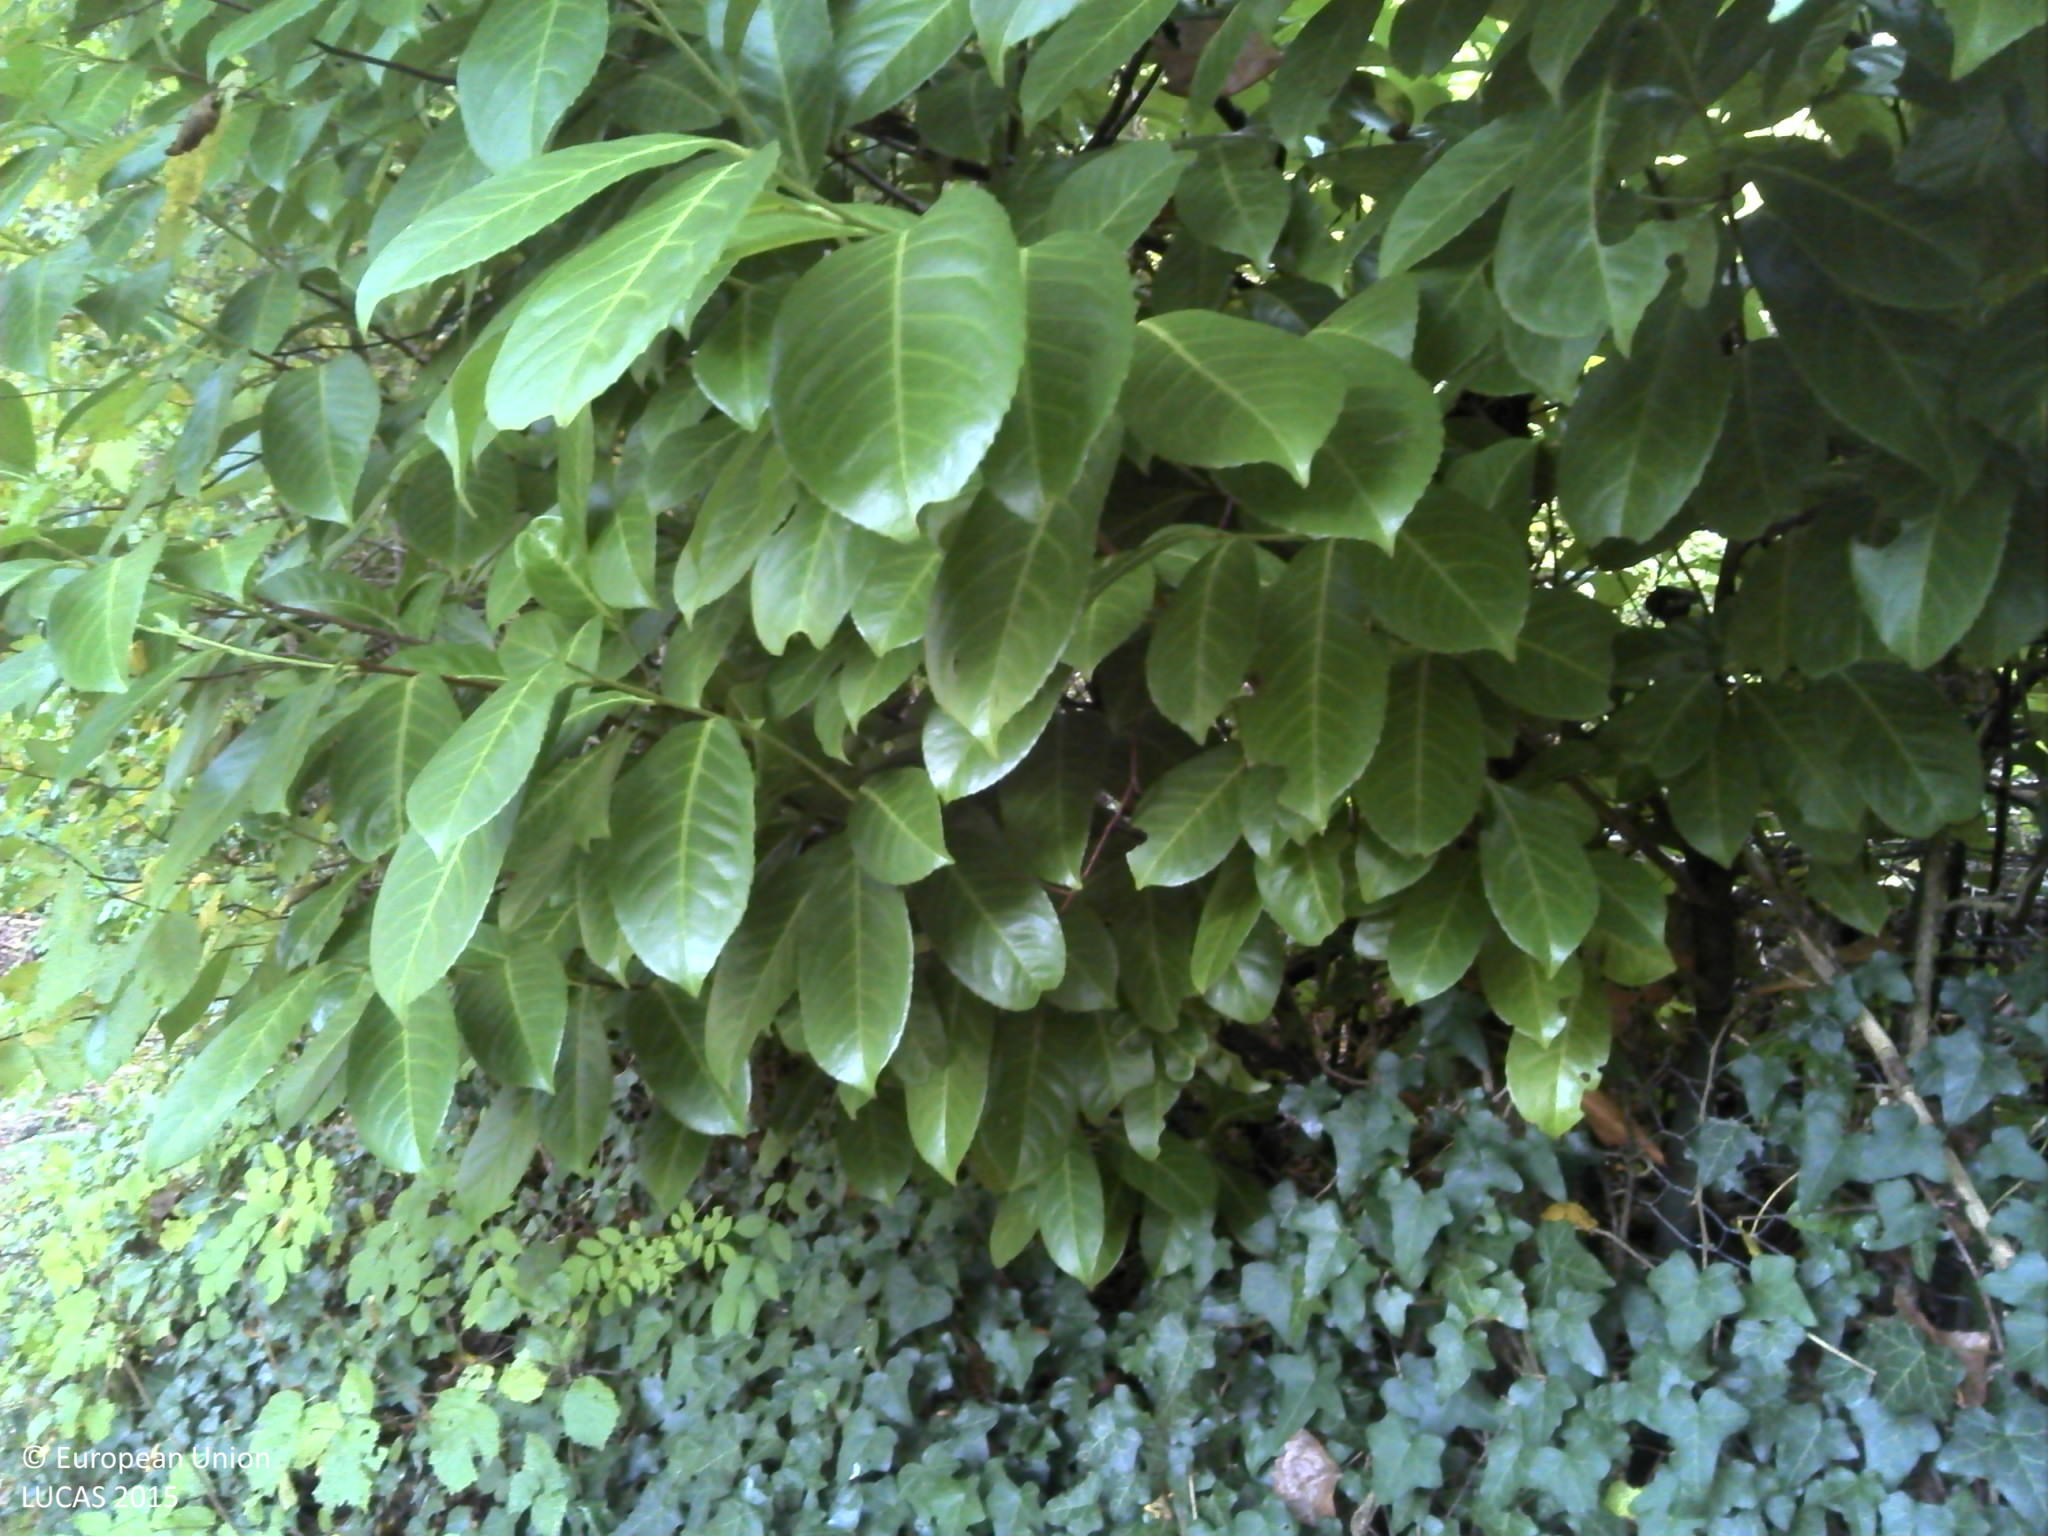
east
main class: Woodland
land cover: Broadleaved woodland
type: mesophytic deciduous forest
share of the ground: > 75 %
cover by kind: broadleaved forest trees 90 %, shrubs 5 %, herbaceous plants 5 %
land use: Forestry
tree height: > 5 m
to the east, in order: Broadleaved woodland; Tracks; Broadleaved woodland
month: October
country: FR
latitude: 46.0534
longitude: 5.3892
